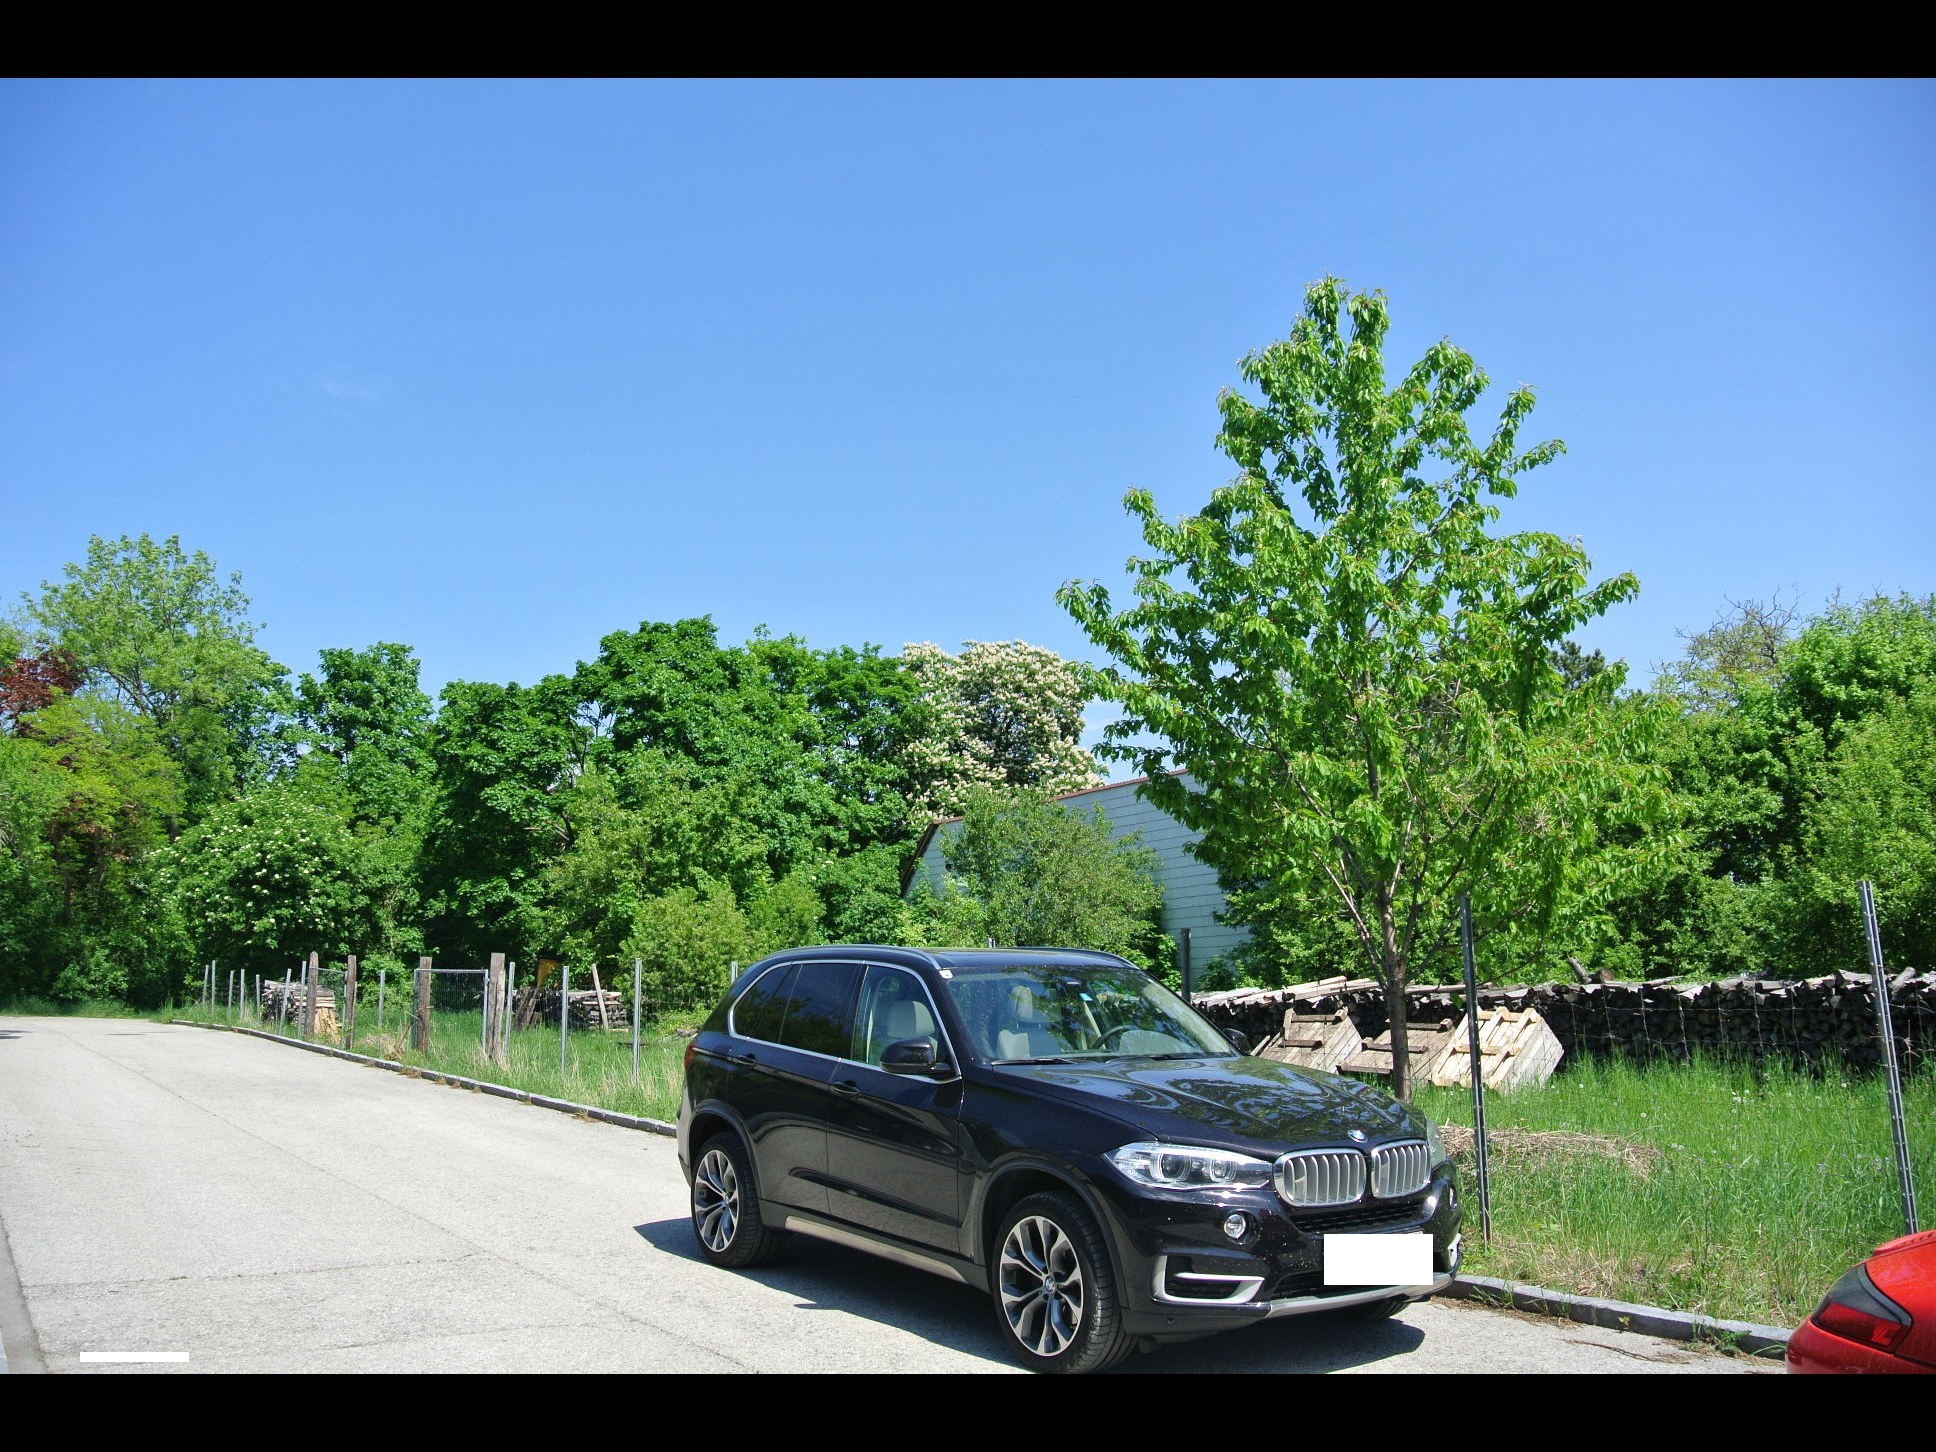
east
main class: Grassland
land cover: Grassland with sparse tree/shrub cover
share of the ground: > 75 %
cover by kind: herbaceous plants 85 %, shrubs 10 %, broadleaved forest trees 5 %
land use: Residential
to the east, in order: Grassland with sparse tree/shrub cover; Artificial constructions in urban areas; Grassland with sparse tree/shrub cover; Broadleaved woodland
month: May
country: AT
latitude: 48.1183
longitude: 16.2508
